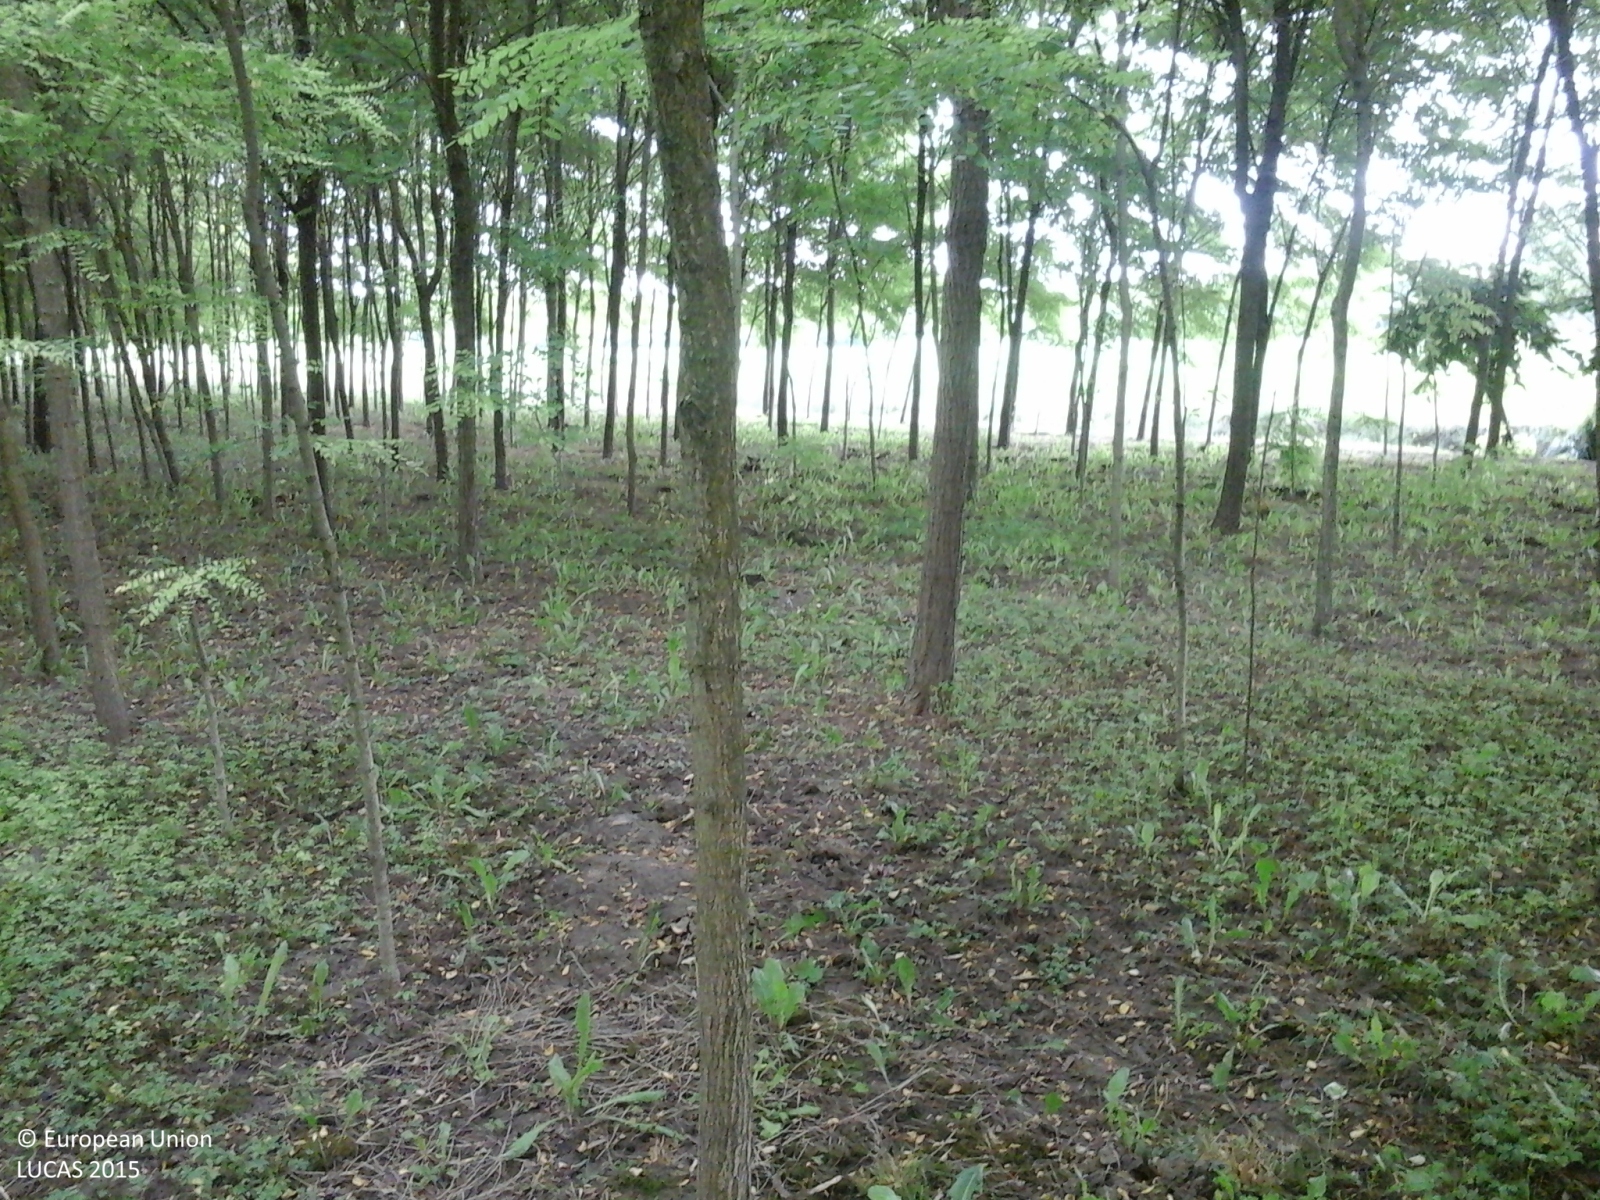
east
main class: Woodland
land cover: Broadleaved woodland
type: thermophilous deciduous forest
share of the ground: > 75 %
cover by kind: broadleaved forest trees 100 %
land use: Forestry
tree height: > 5 m
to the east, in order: Broadleaved woodland; Ditches and canals; Grass margins; Soya; Ditches and canals; Soya; Electric lines; Ditches and canals; Abandoned hedges; Grass margins; Tracks; Spontaneously vegetated surfaces; Abandoned hedges; Ditches and canals; Fences; Soya
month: June
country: IT
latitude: 45.6881
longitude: 12.6286
